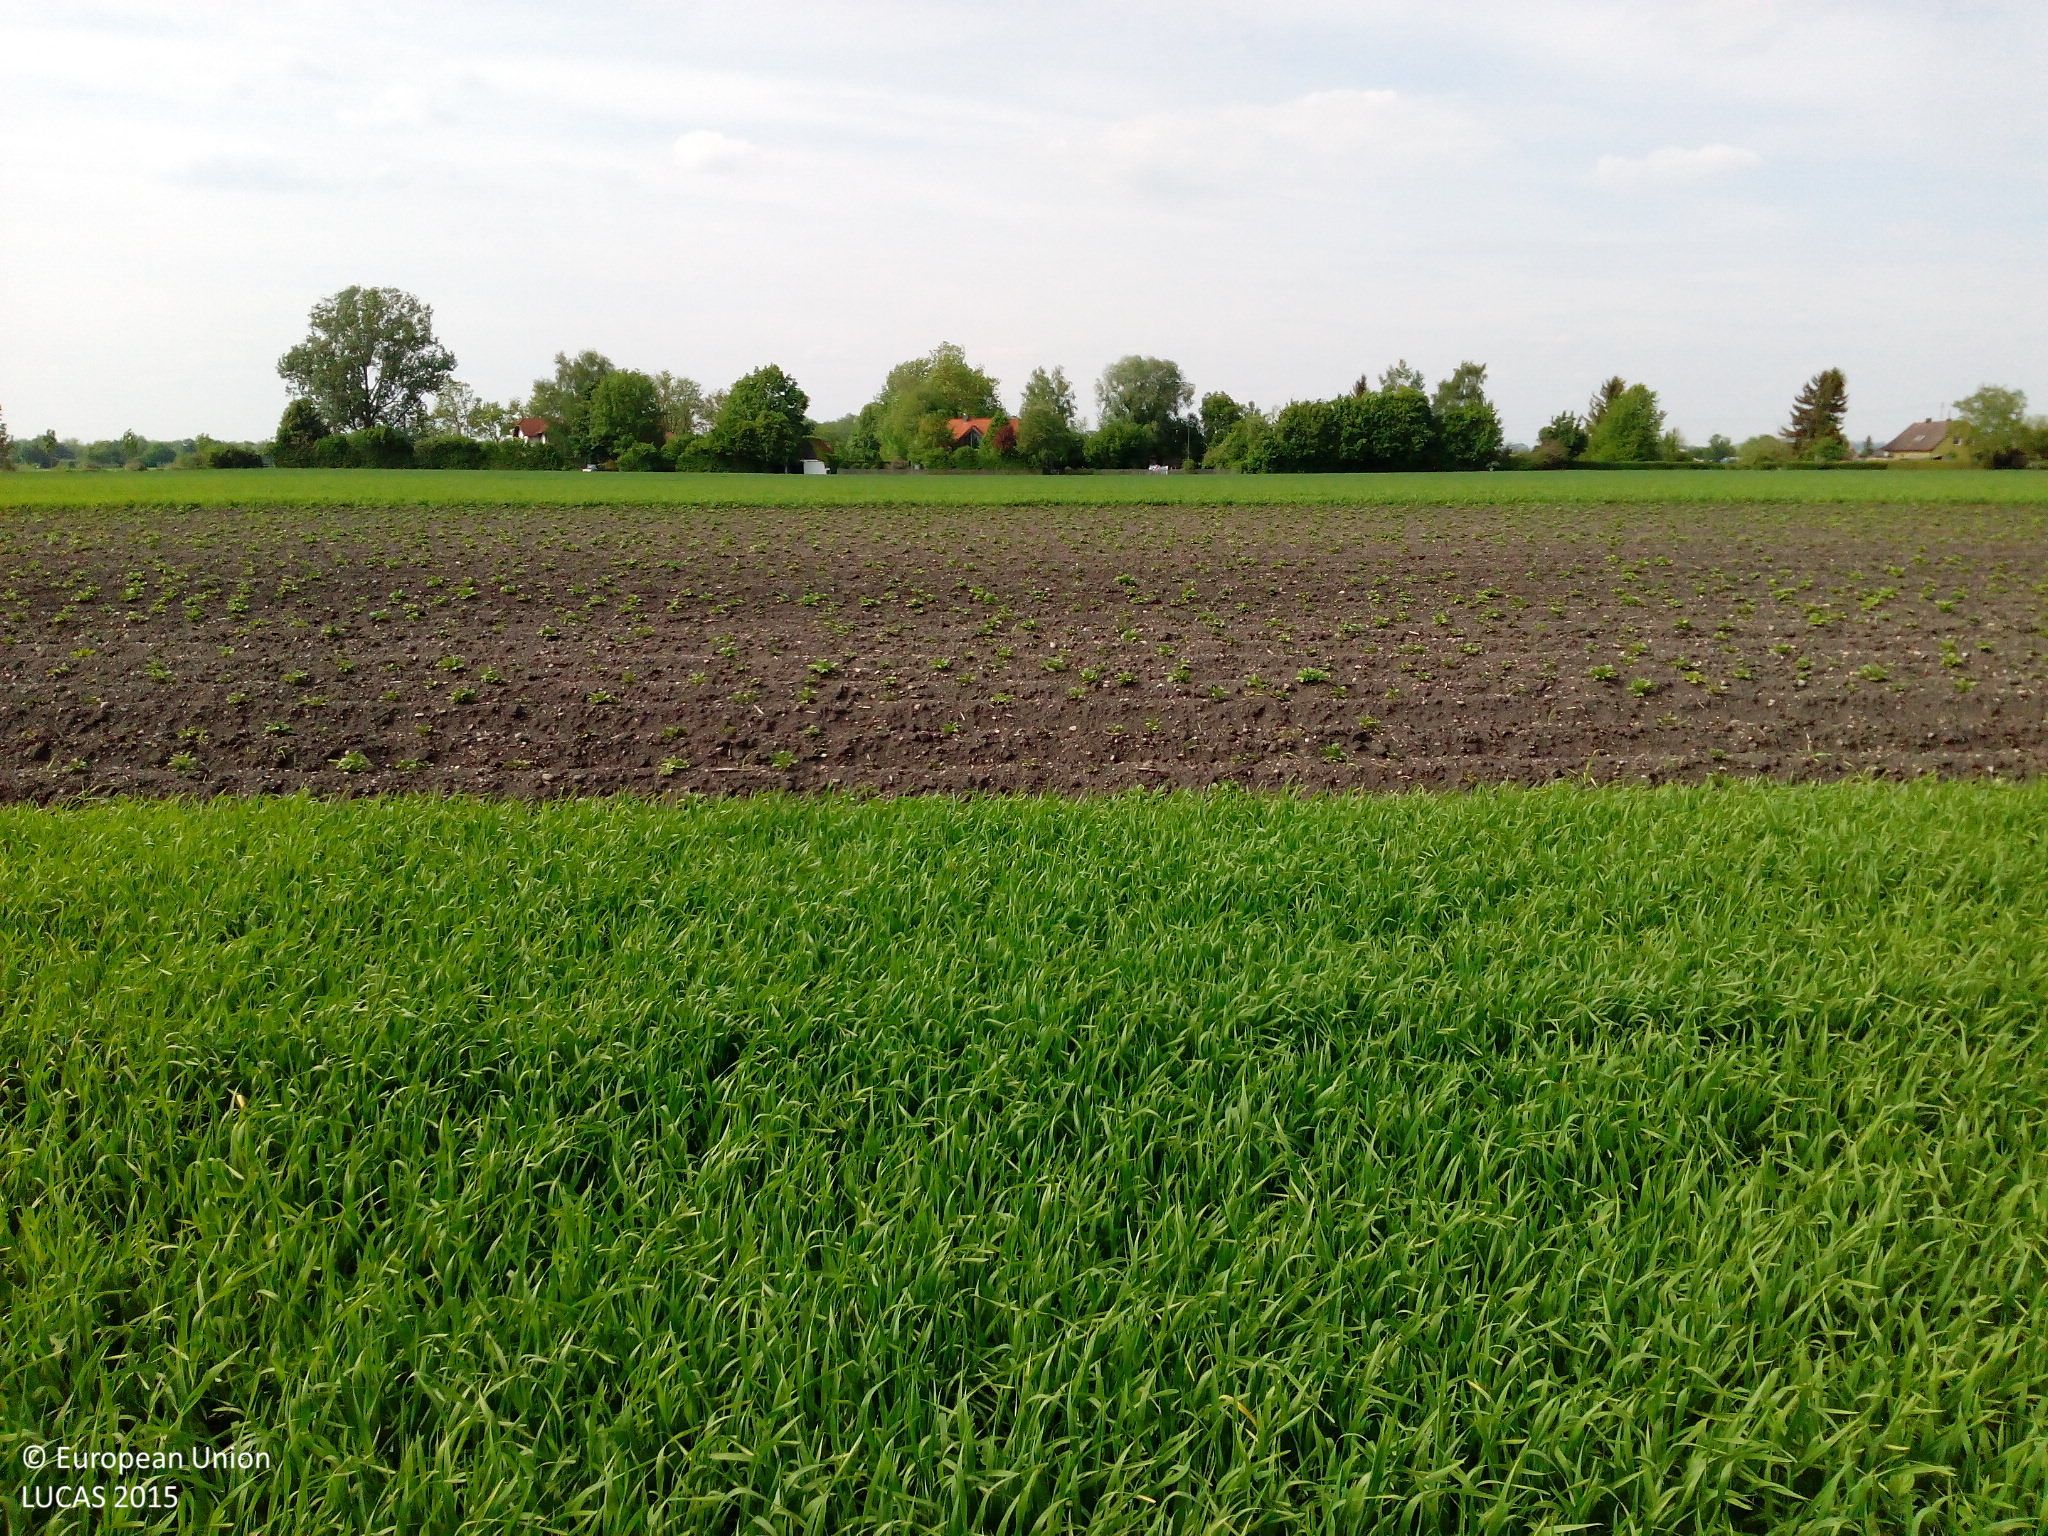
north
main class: Cropland
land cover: Common wheat
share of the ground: > 75 %
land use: Agriculture (excluding fallow land and kitchen gardens)
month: May
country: DE
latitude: 48.2152
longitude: 11.3585
